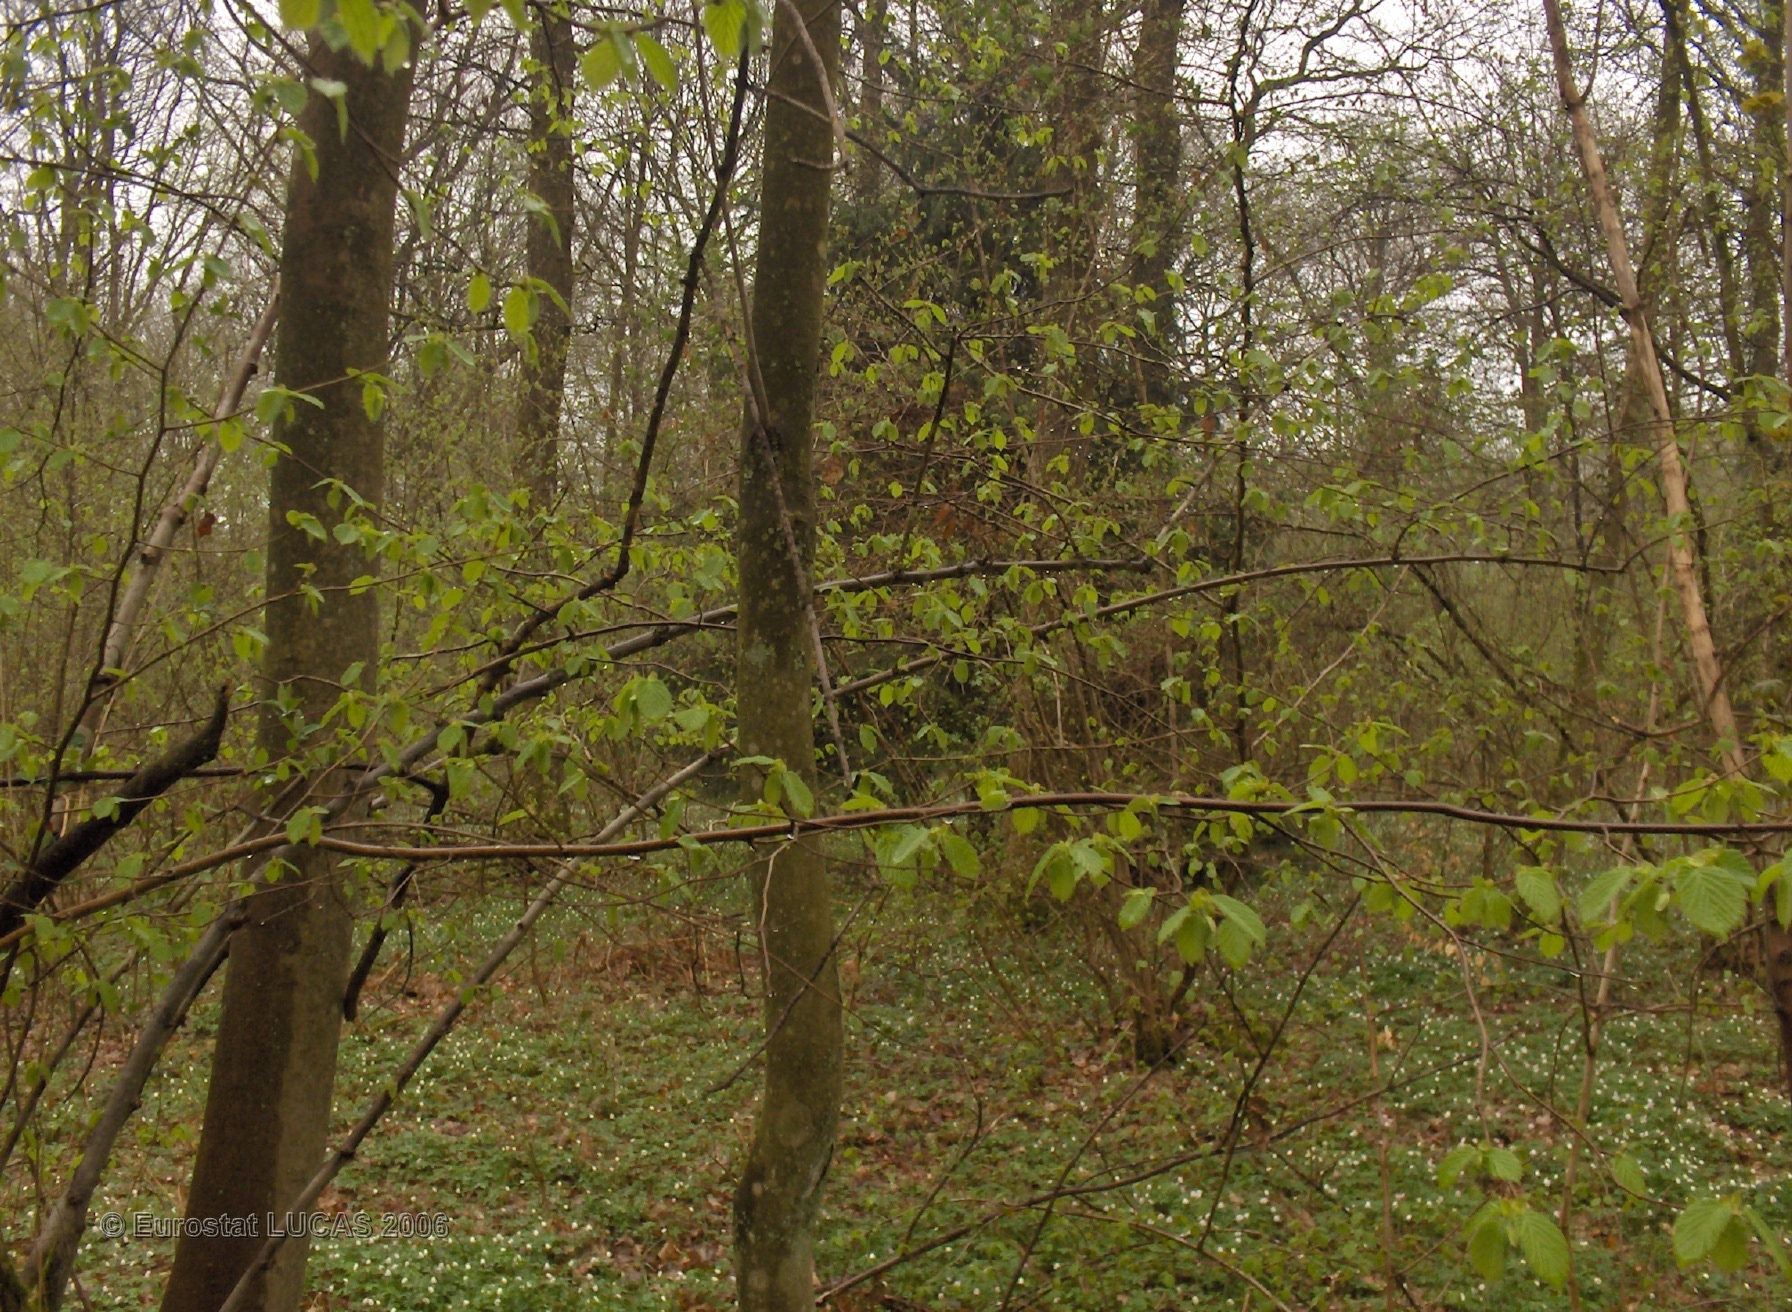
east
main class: Woodland
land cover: Broadleaved forest
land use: Forestry
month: April
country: BE
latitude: 50.2903
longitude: 4.5923
